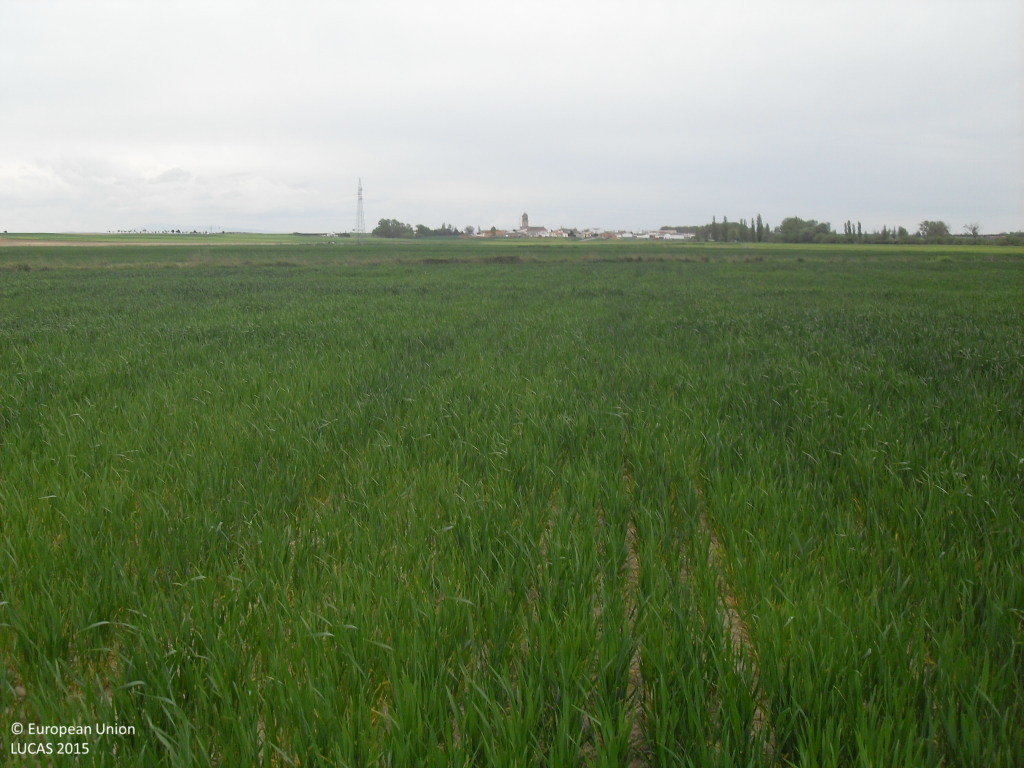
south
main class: Cropland
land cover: Common wheat
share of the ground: > 75 %
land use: Agriculture (excluding fallow land and kitchen gardens)
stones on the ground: < 10 %
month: April
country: ES
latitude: 40.9183
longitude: -5.1587
